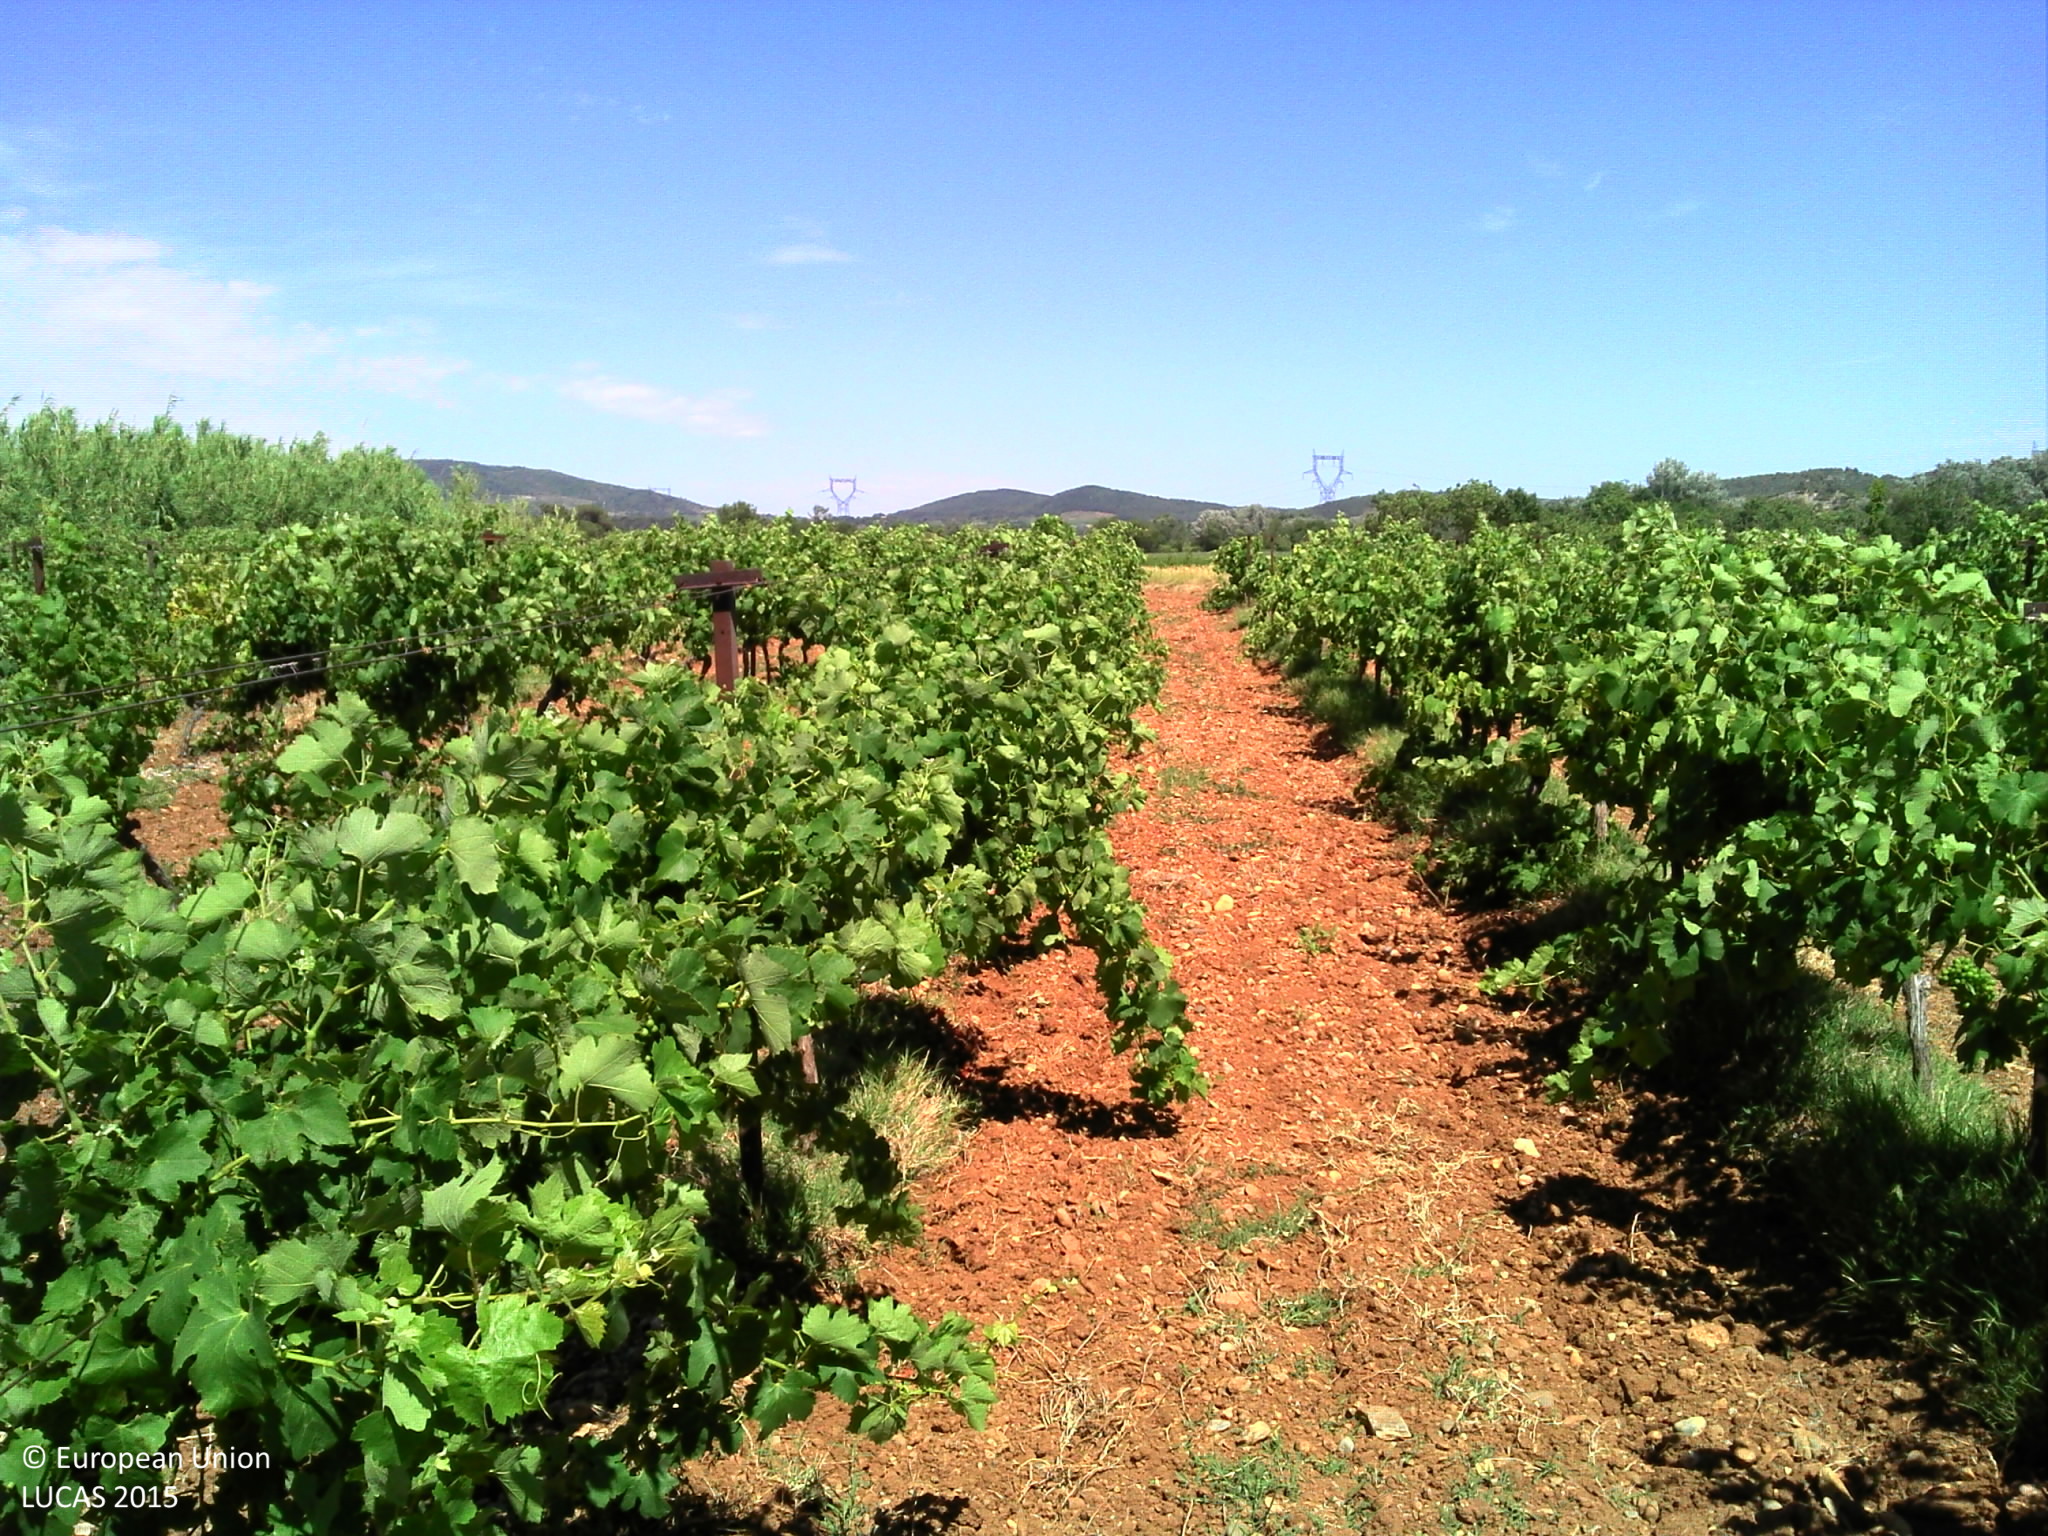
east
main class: Cropland
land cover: Vineyards
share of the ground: 50 - 75 %
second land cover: Other bare soil
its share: > 75 %
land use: Agriculture (excluding fallow land and kitchen gardens)
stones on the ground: 25 - 50 %
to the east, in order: Vineyards; Other bare soil; Grass margins; Ditches and canals; Paved roads, cycling and walking lanes; Ditches and canals; Tracks; Grassland without tree/shrub cover; Vineyards; Ditches and canals; Shruby margins; Grassland without tree/shrub cover; Vineyards
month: June
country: FR
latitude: 43.2605
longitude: 2.7037
